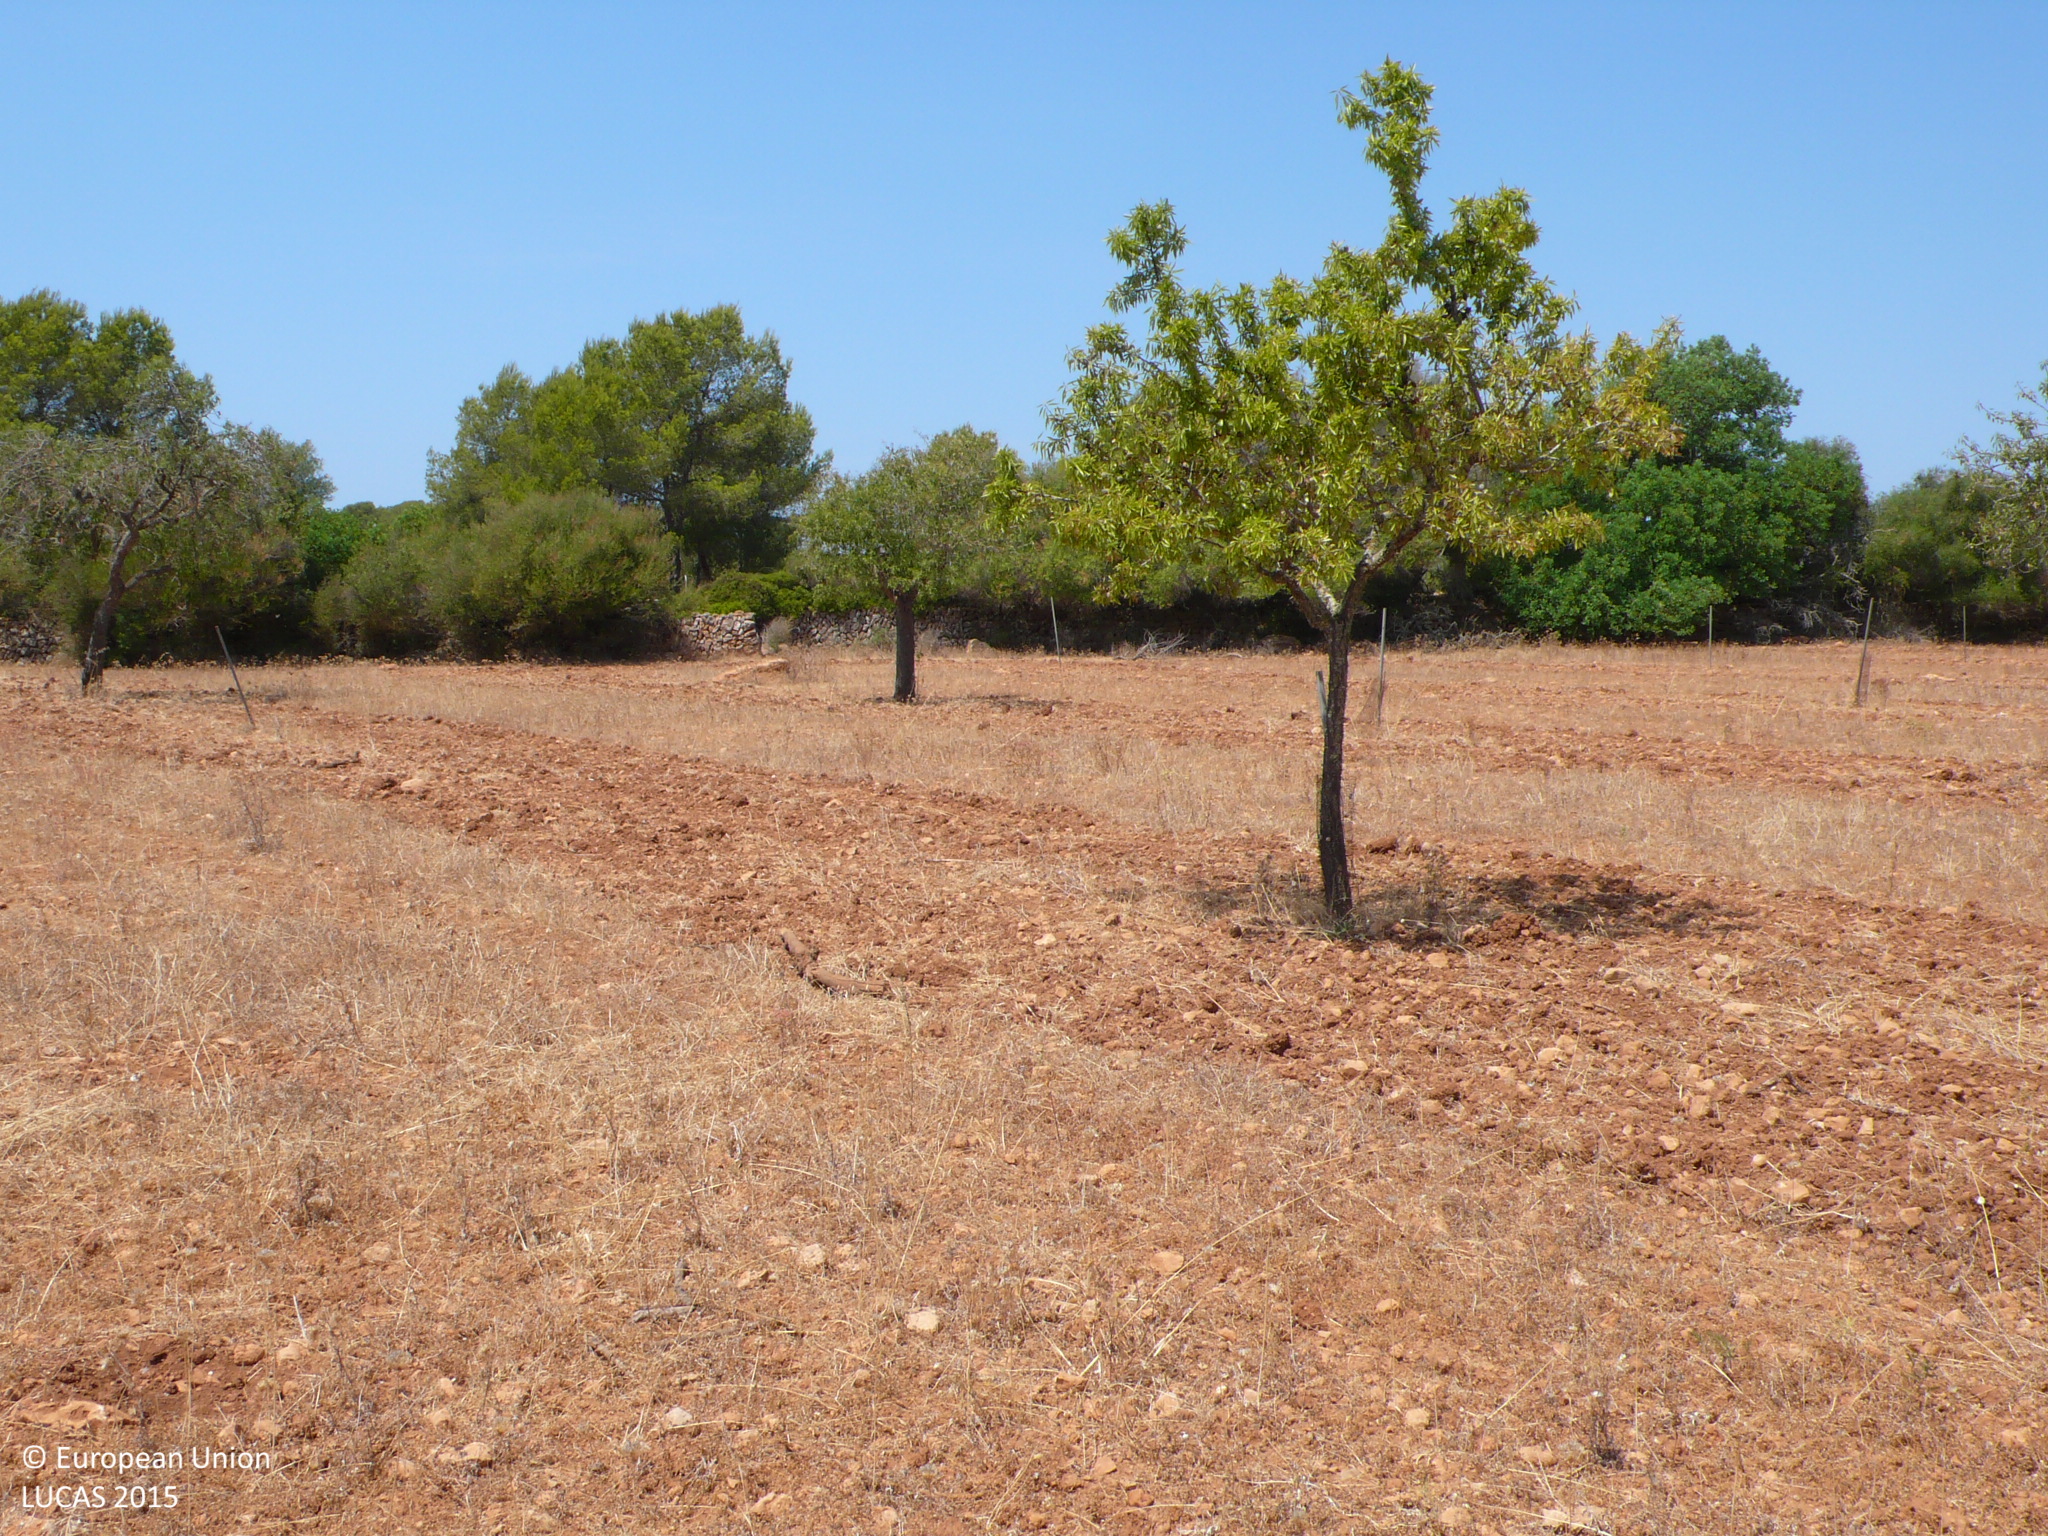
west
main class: Cropland
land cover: Nuts trees
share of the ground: 10 - 25 %
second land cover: Spontaneously vegetated surfaces
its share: 10 - 25 %
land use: Agriculture (excluding fallow land and kitchen gardens)
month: July
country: ES
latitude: 39.4044
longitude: 2.8199
